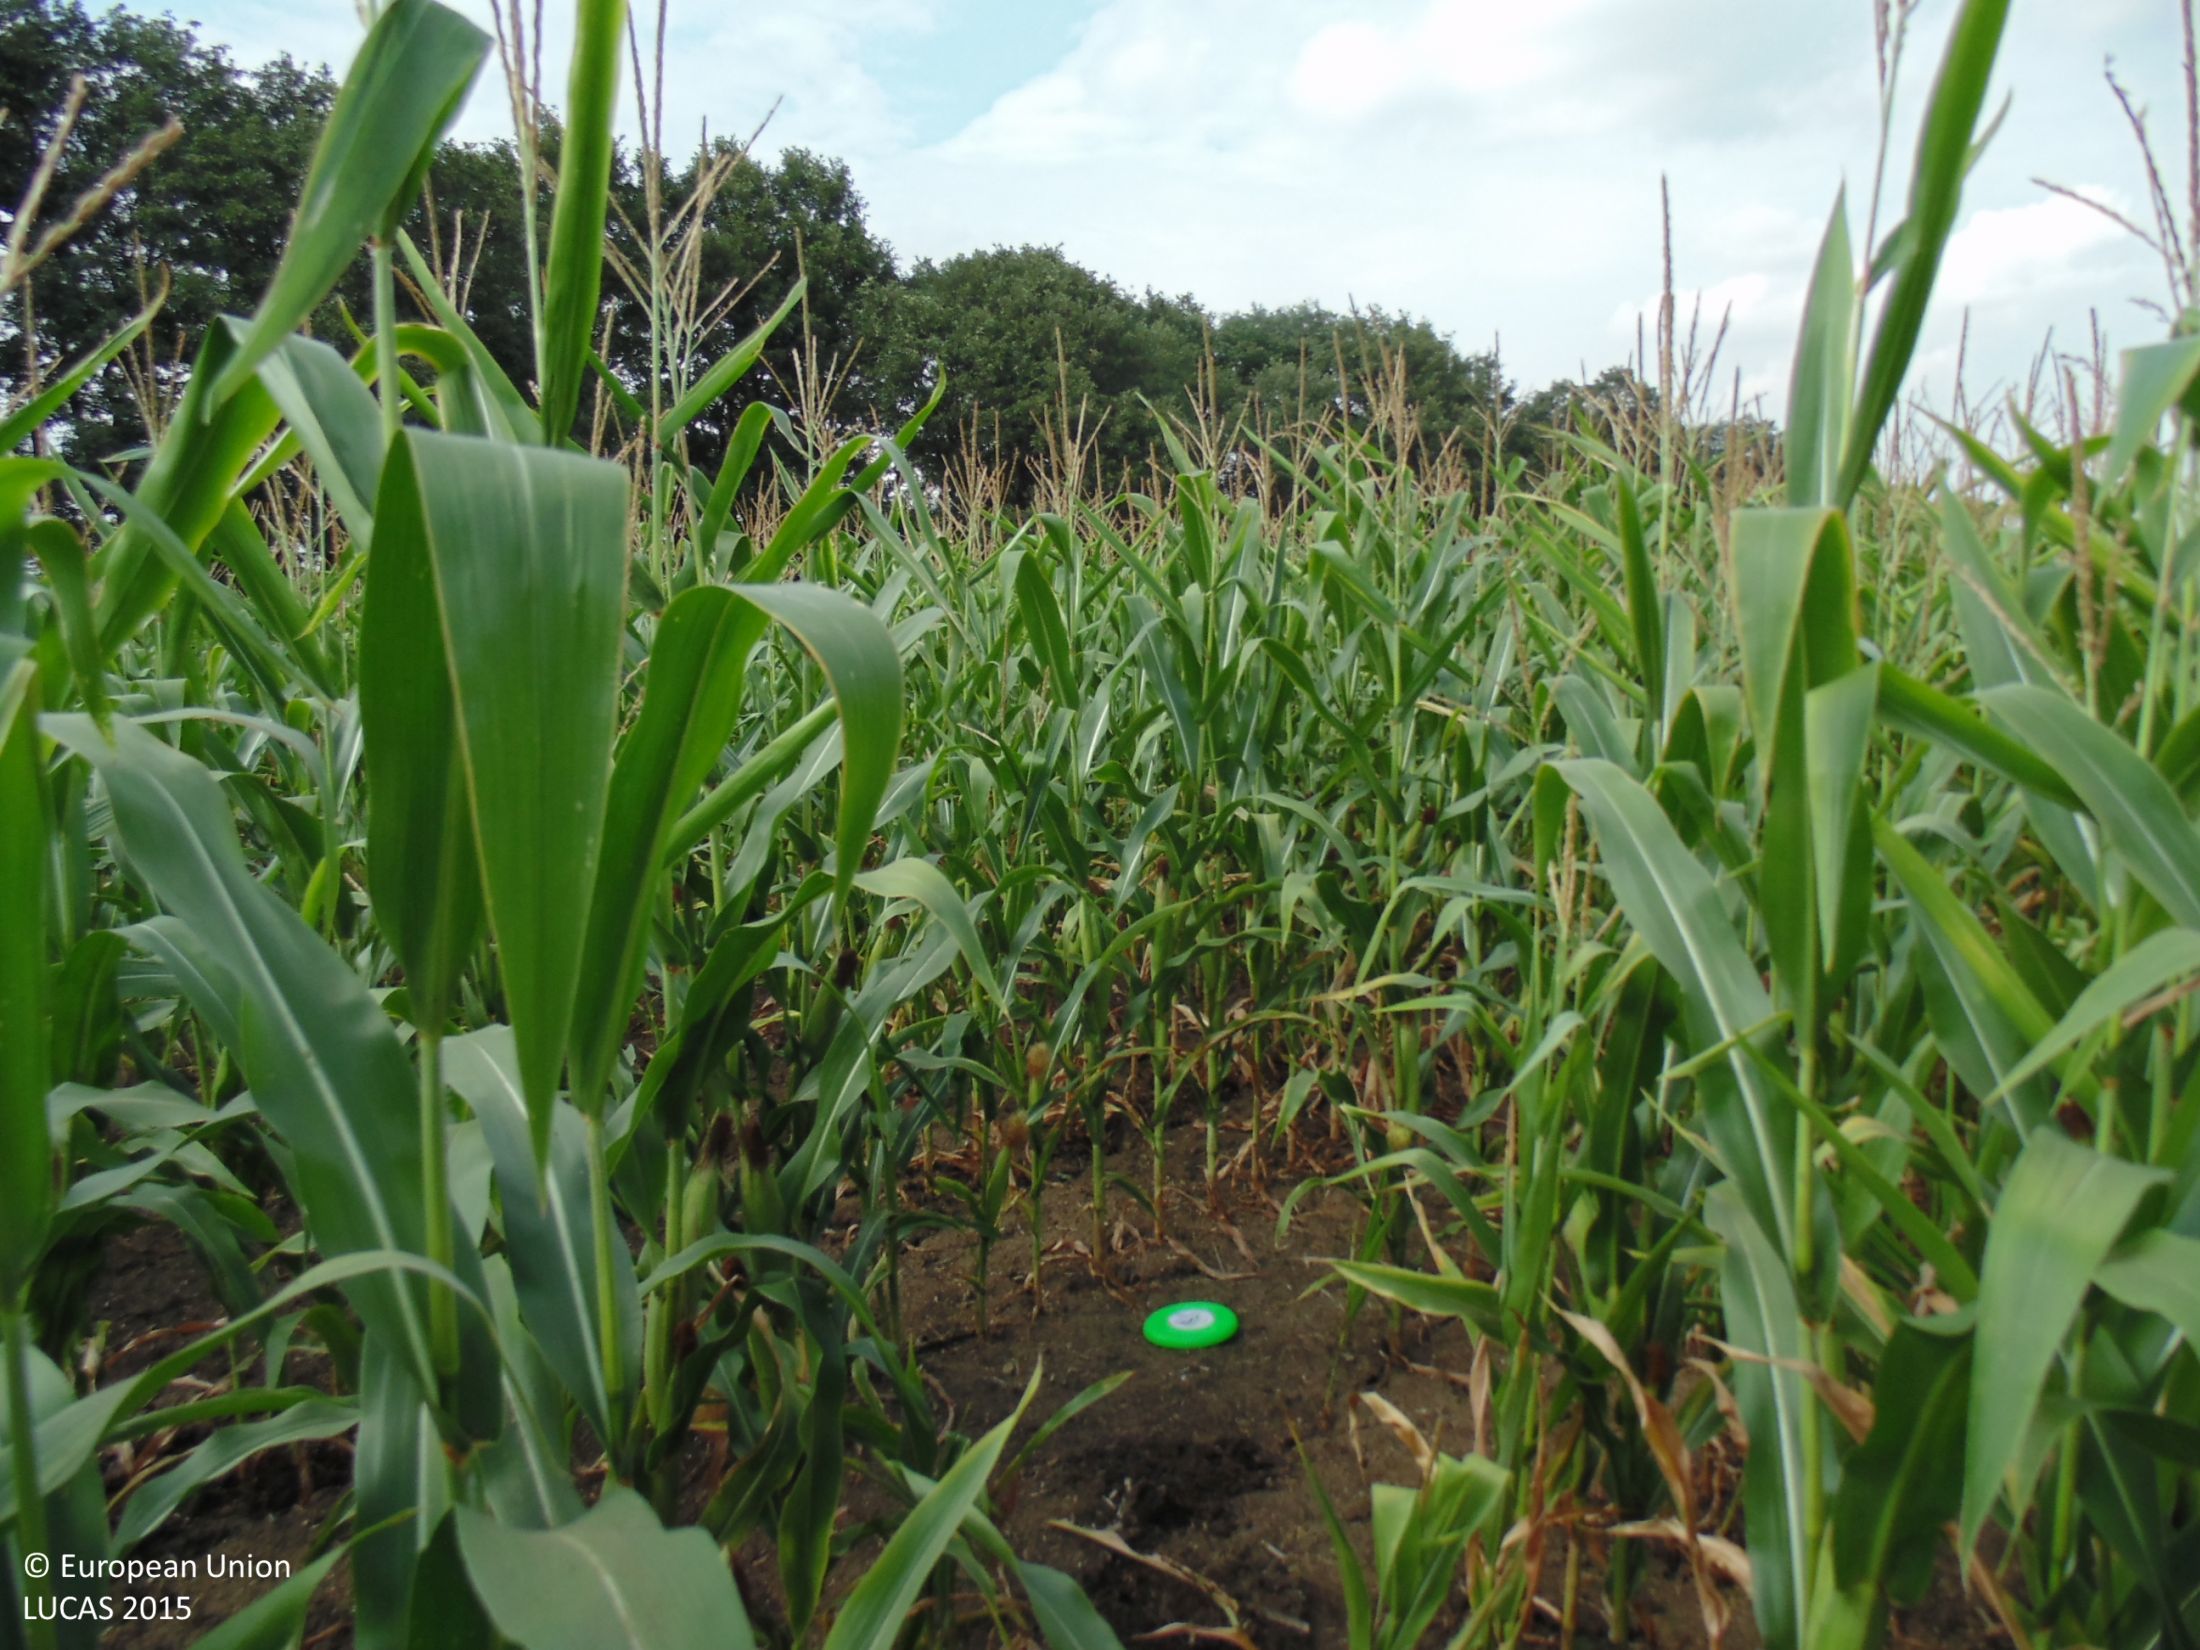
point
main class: Cropland
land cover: Maize
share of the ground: > 75 %
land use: Agriculture (excluding fallow land and kitchen gardens)
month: August
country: BG
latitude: 43.7311
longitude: 28.0396
